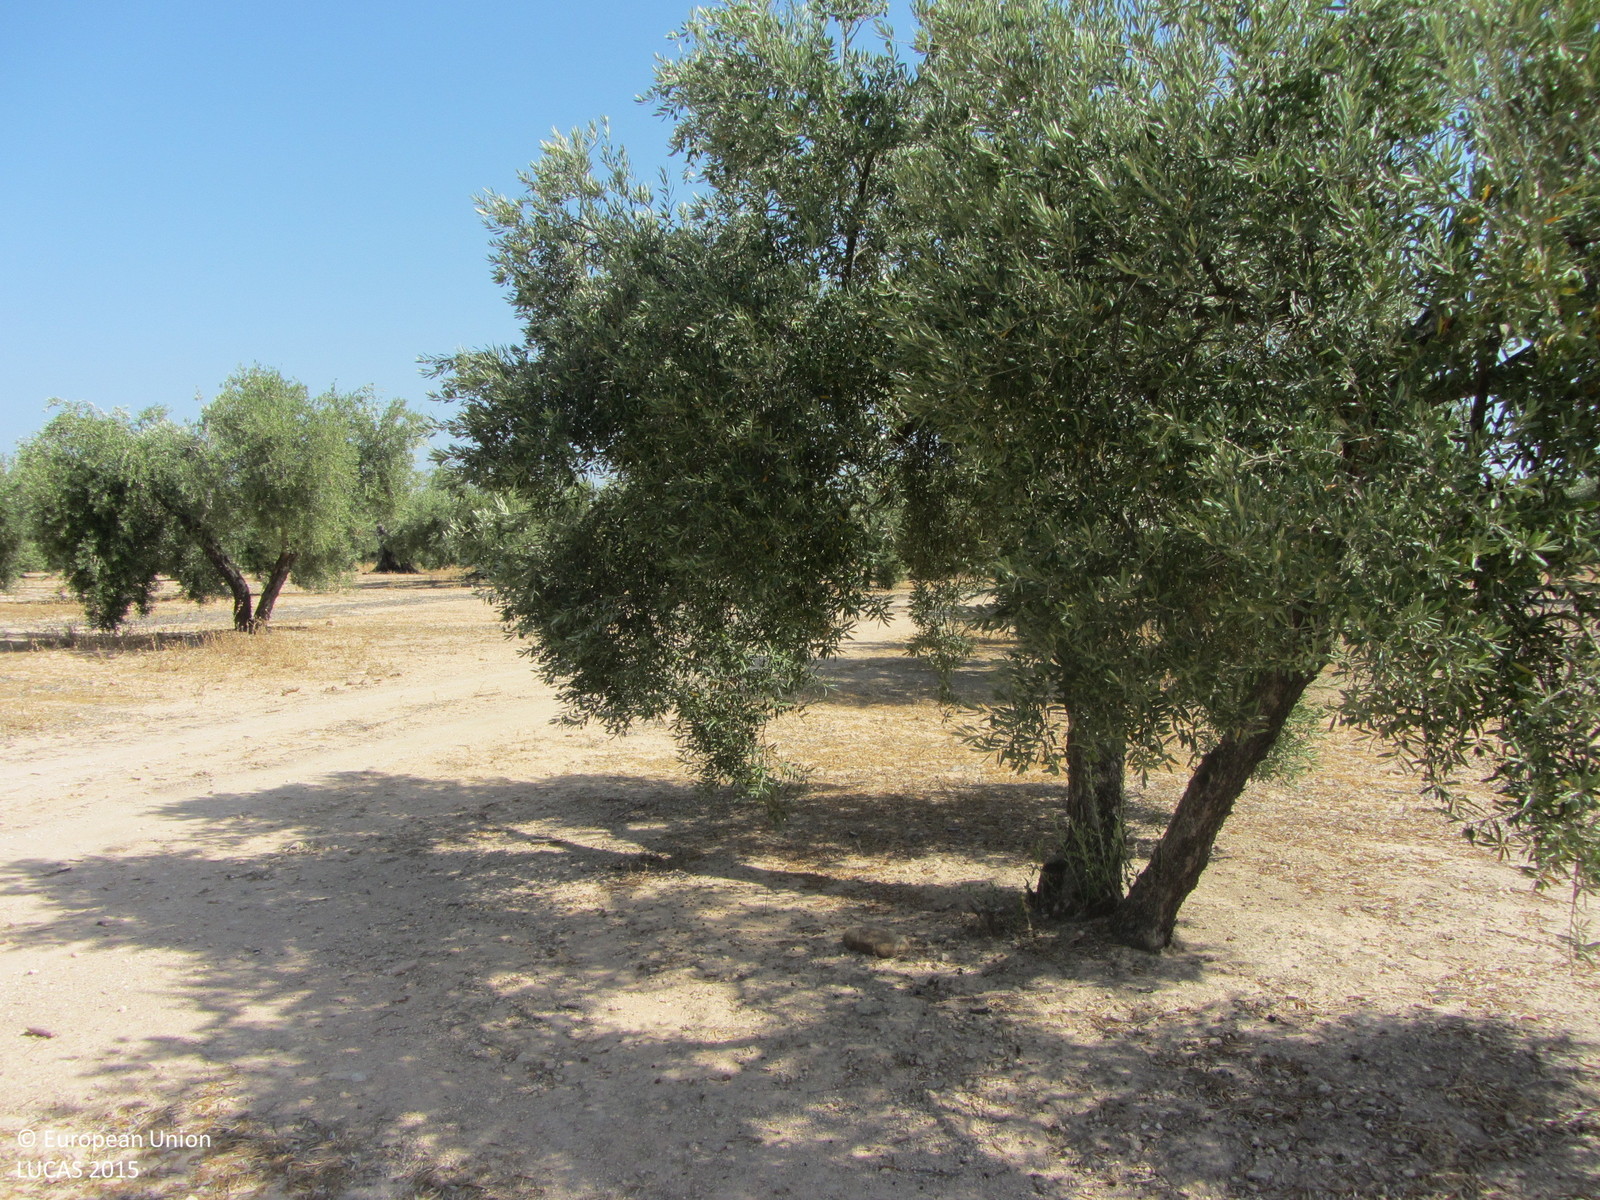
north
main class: Cropland
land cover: Olive groves
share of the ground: 25 - 50 %
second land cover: Other bare soil
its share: > 75 %
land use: Agriculture (excluding fallow land and kitchen gardens)
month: July
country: ES
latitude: 37.9976
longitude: -4.2093
